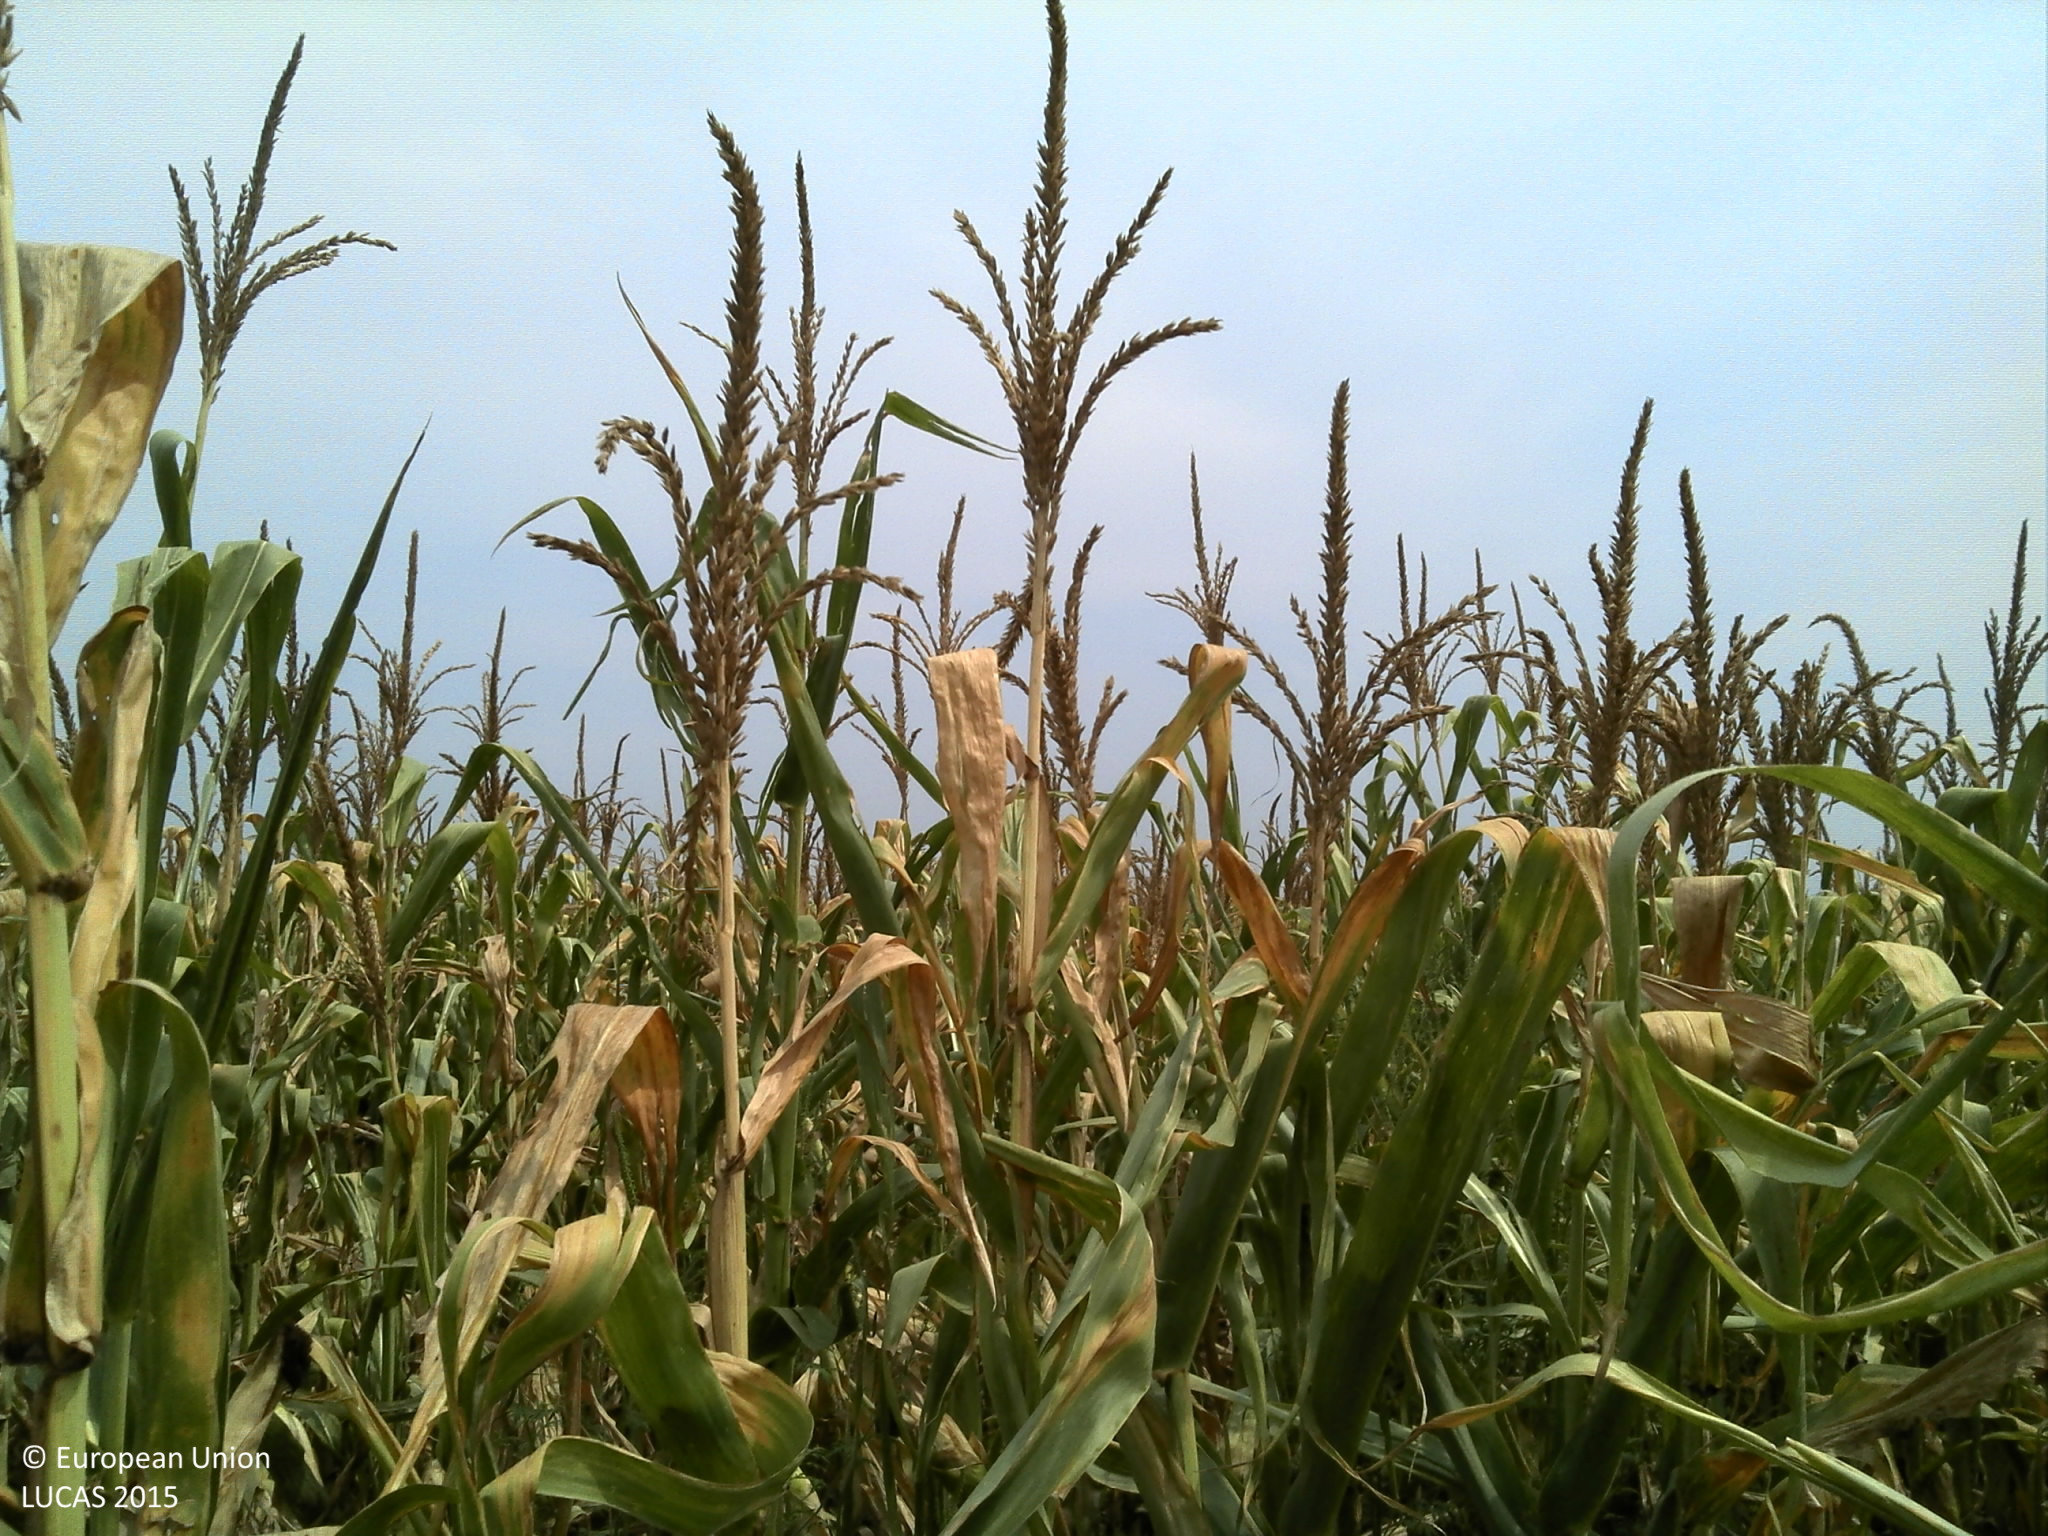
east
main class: Cropland
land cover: Maize
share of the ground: > 75 %
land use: Agriculture (excluding fallow land and kitchen gardens)
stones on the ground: < 10 %
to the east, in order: Maize
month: August
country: HR
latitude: 45.4145
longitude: 18.5036
